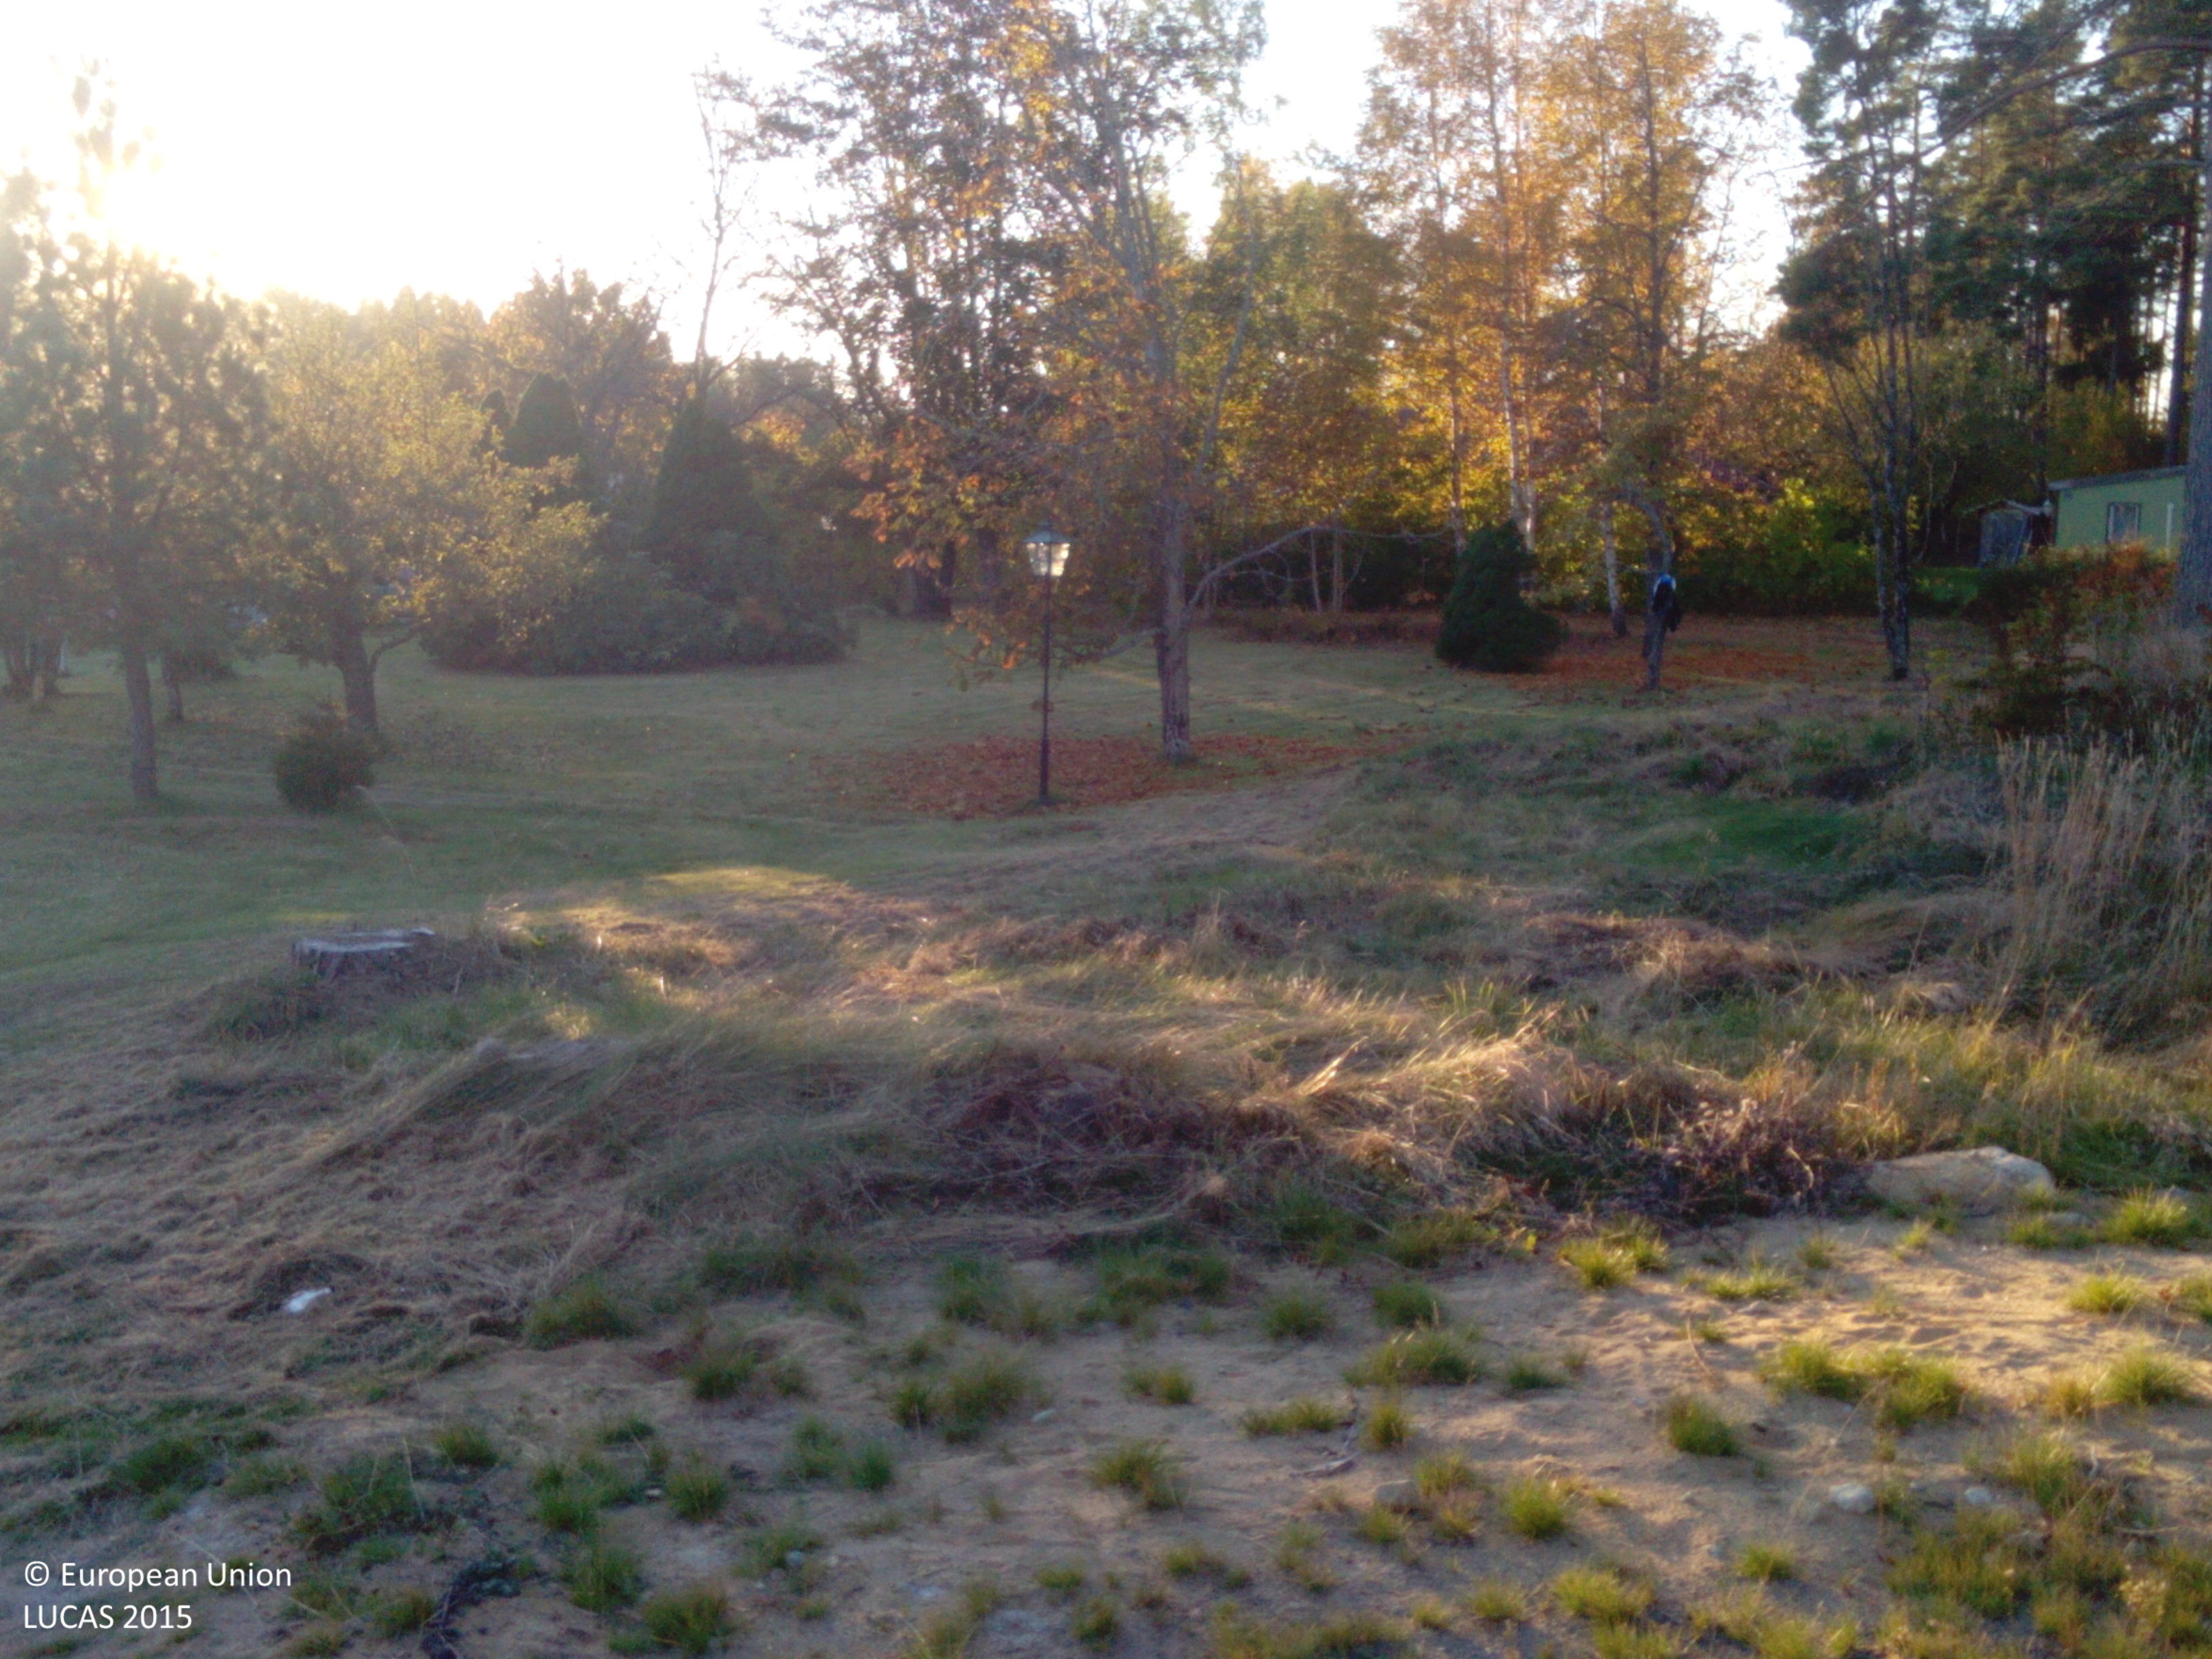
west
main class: Grassland
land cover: Grassland without tree/shrub cover
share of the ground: > 75 %
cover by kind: herbaceous plants 80 %
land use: Residential
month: October
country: SE
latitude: 58.8060
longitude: 16.7987
